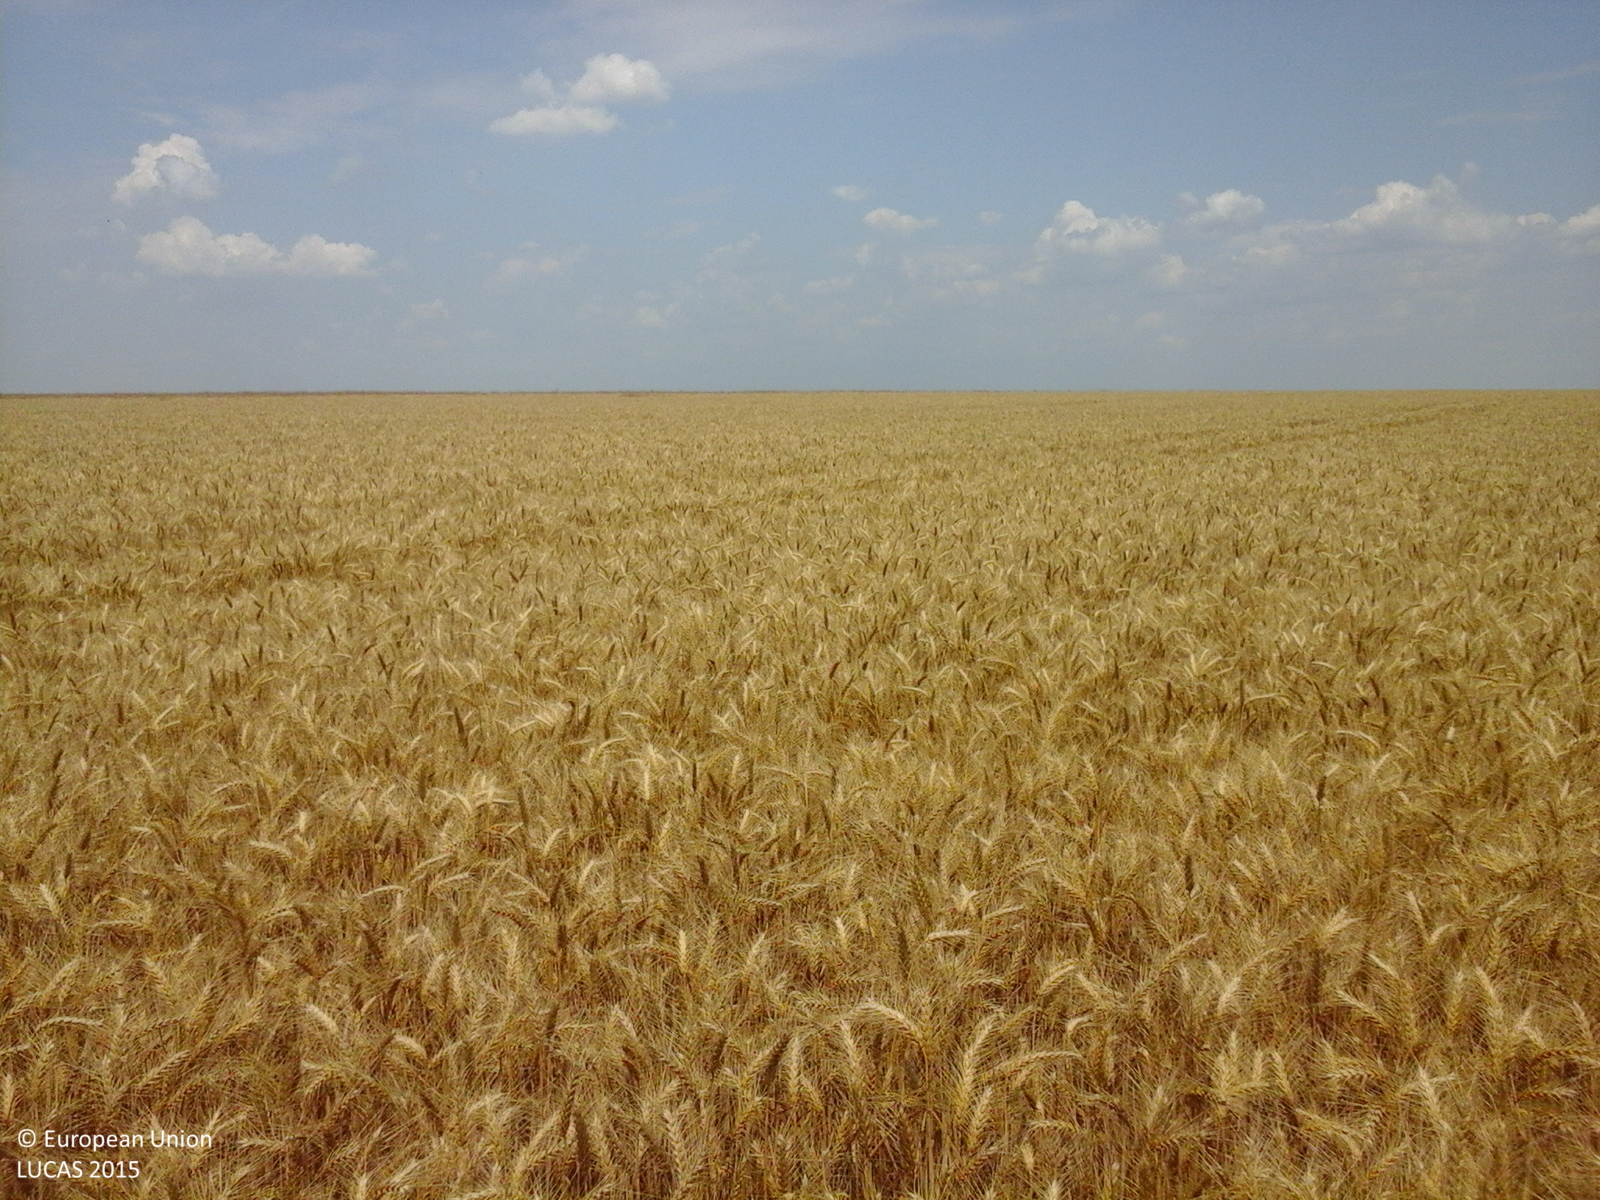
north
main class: Cropland
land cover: Common wheat
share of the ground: > 75 %
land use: Agriculture (excluding fallow land and kitchen gardens)
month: June
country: RO
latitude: 44.2353
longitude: 26.0145
